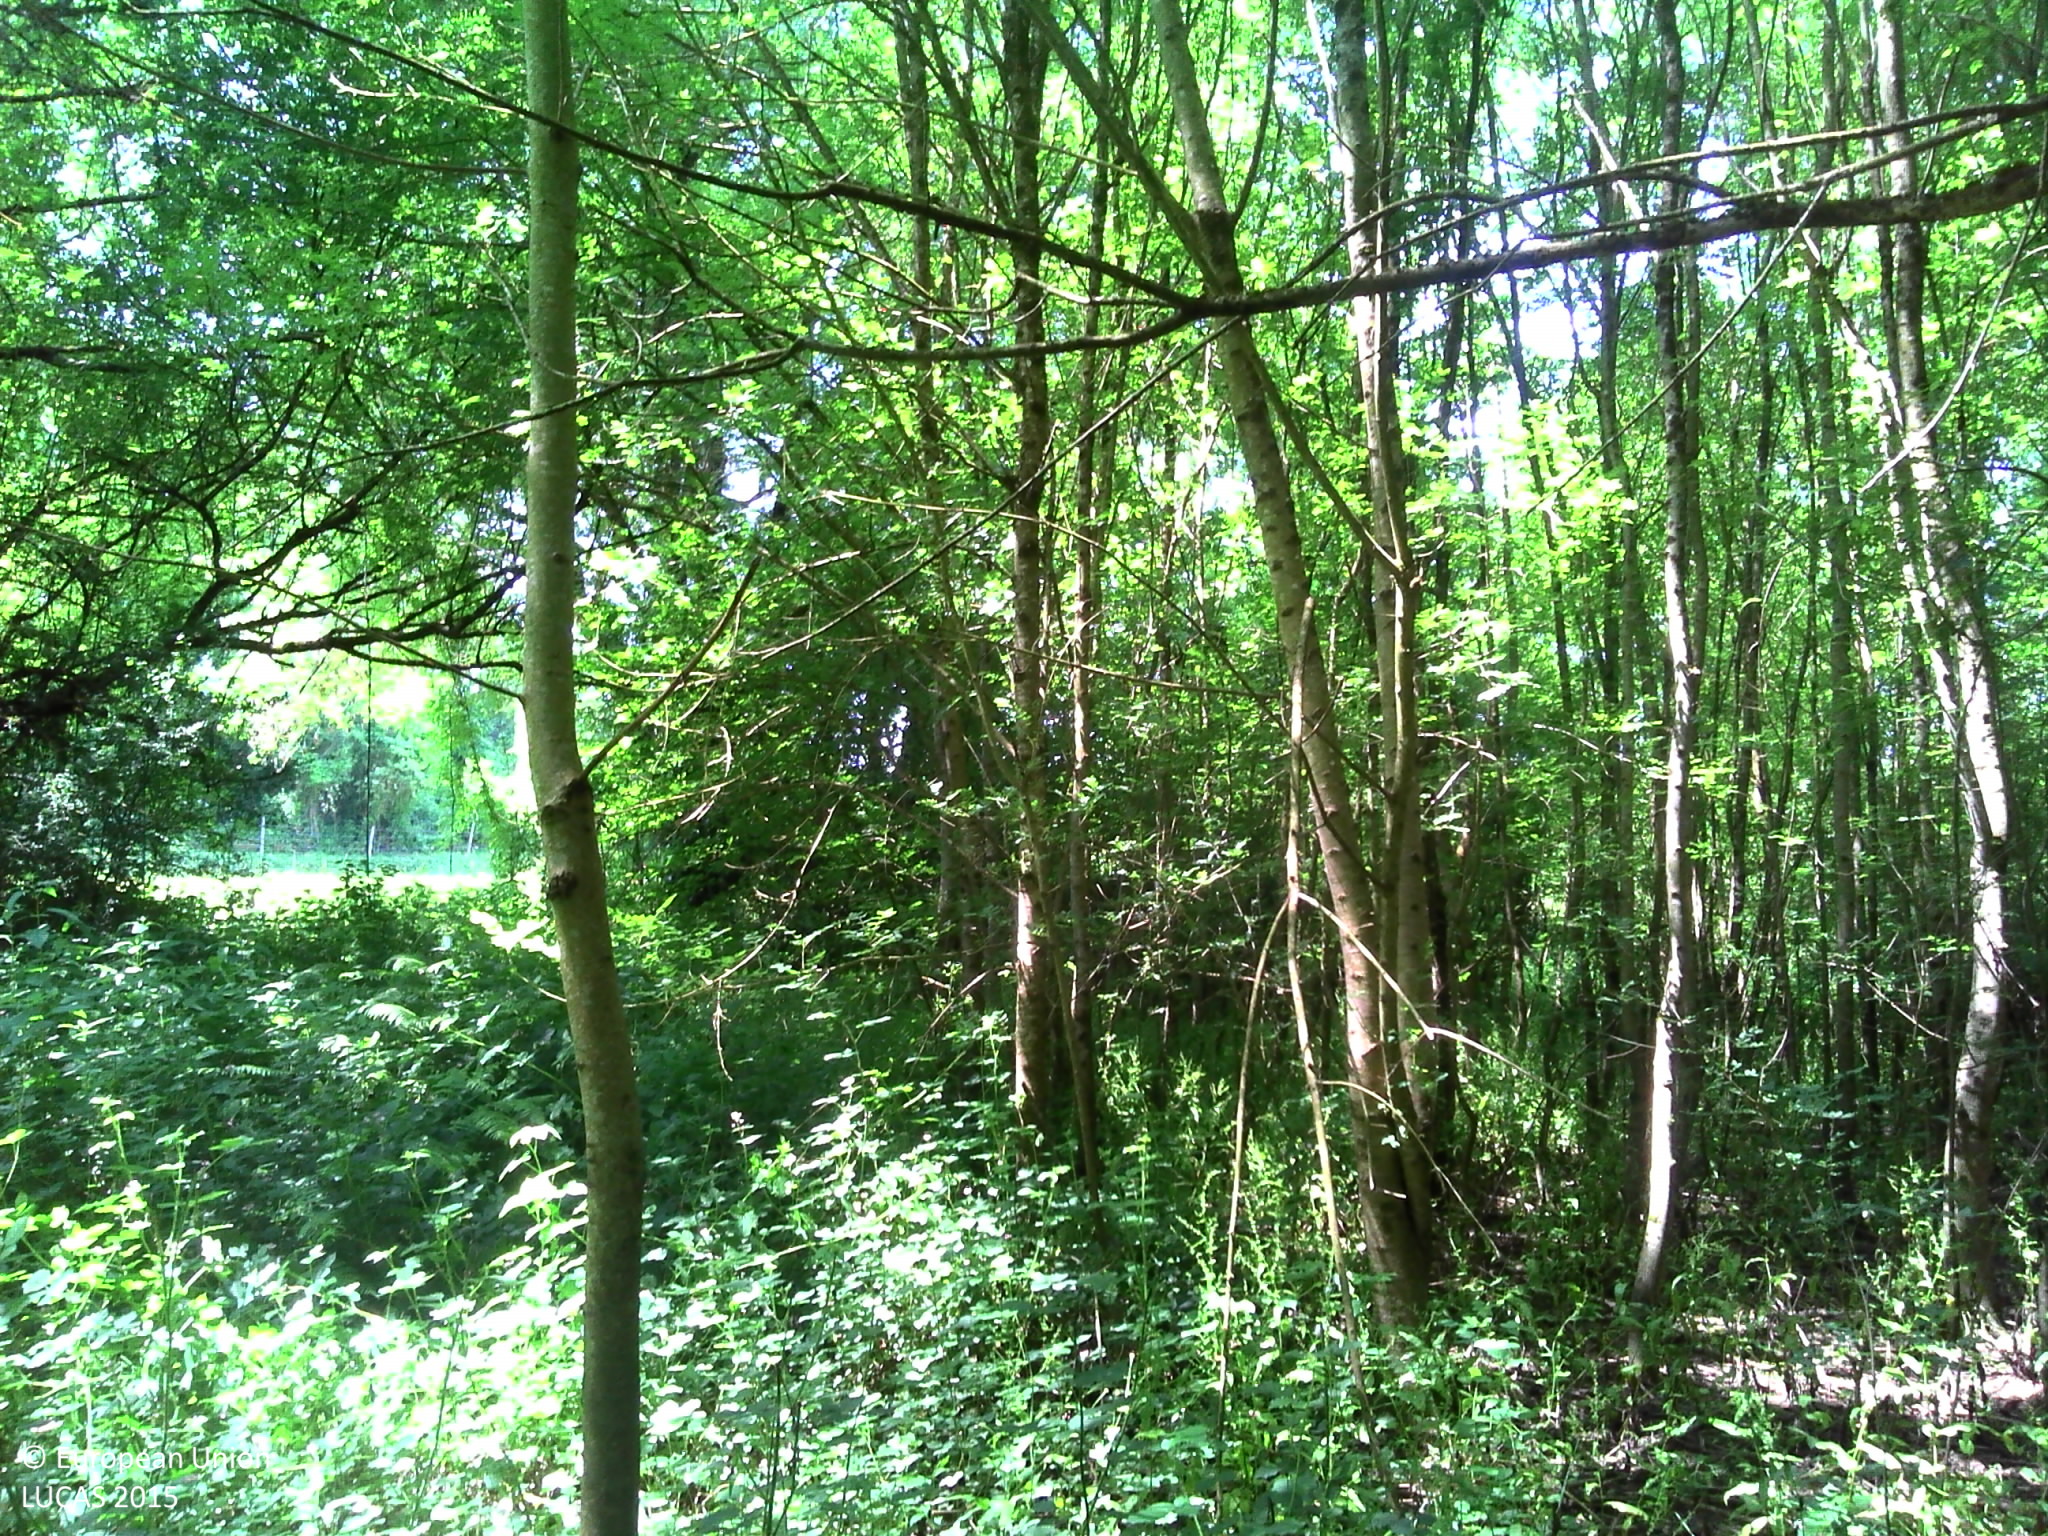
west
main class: Woodland
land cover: Broadleaved woodland
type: floodplain forest
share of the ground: > 75 %
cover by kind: broadleaved forest trees 95 %, herbaceous plants 5 %
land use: Semi-natural and natural areas not in use
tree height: > 5 m
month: June
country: FR
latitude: 47.1374
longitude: -1.4186
